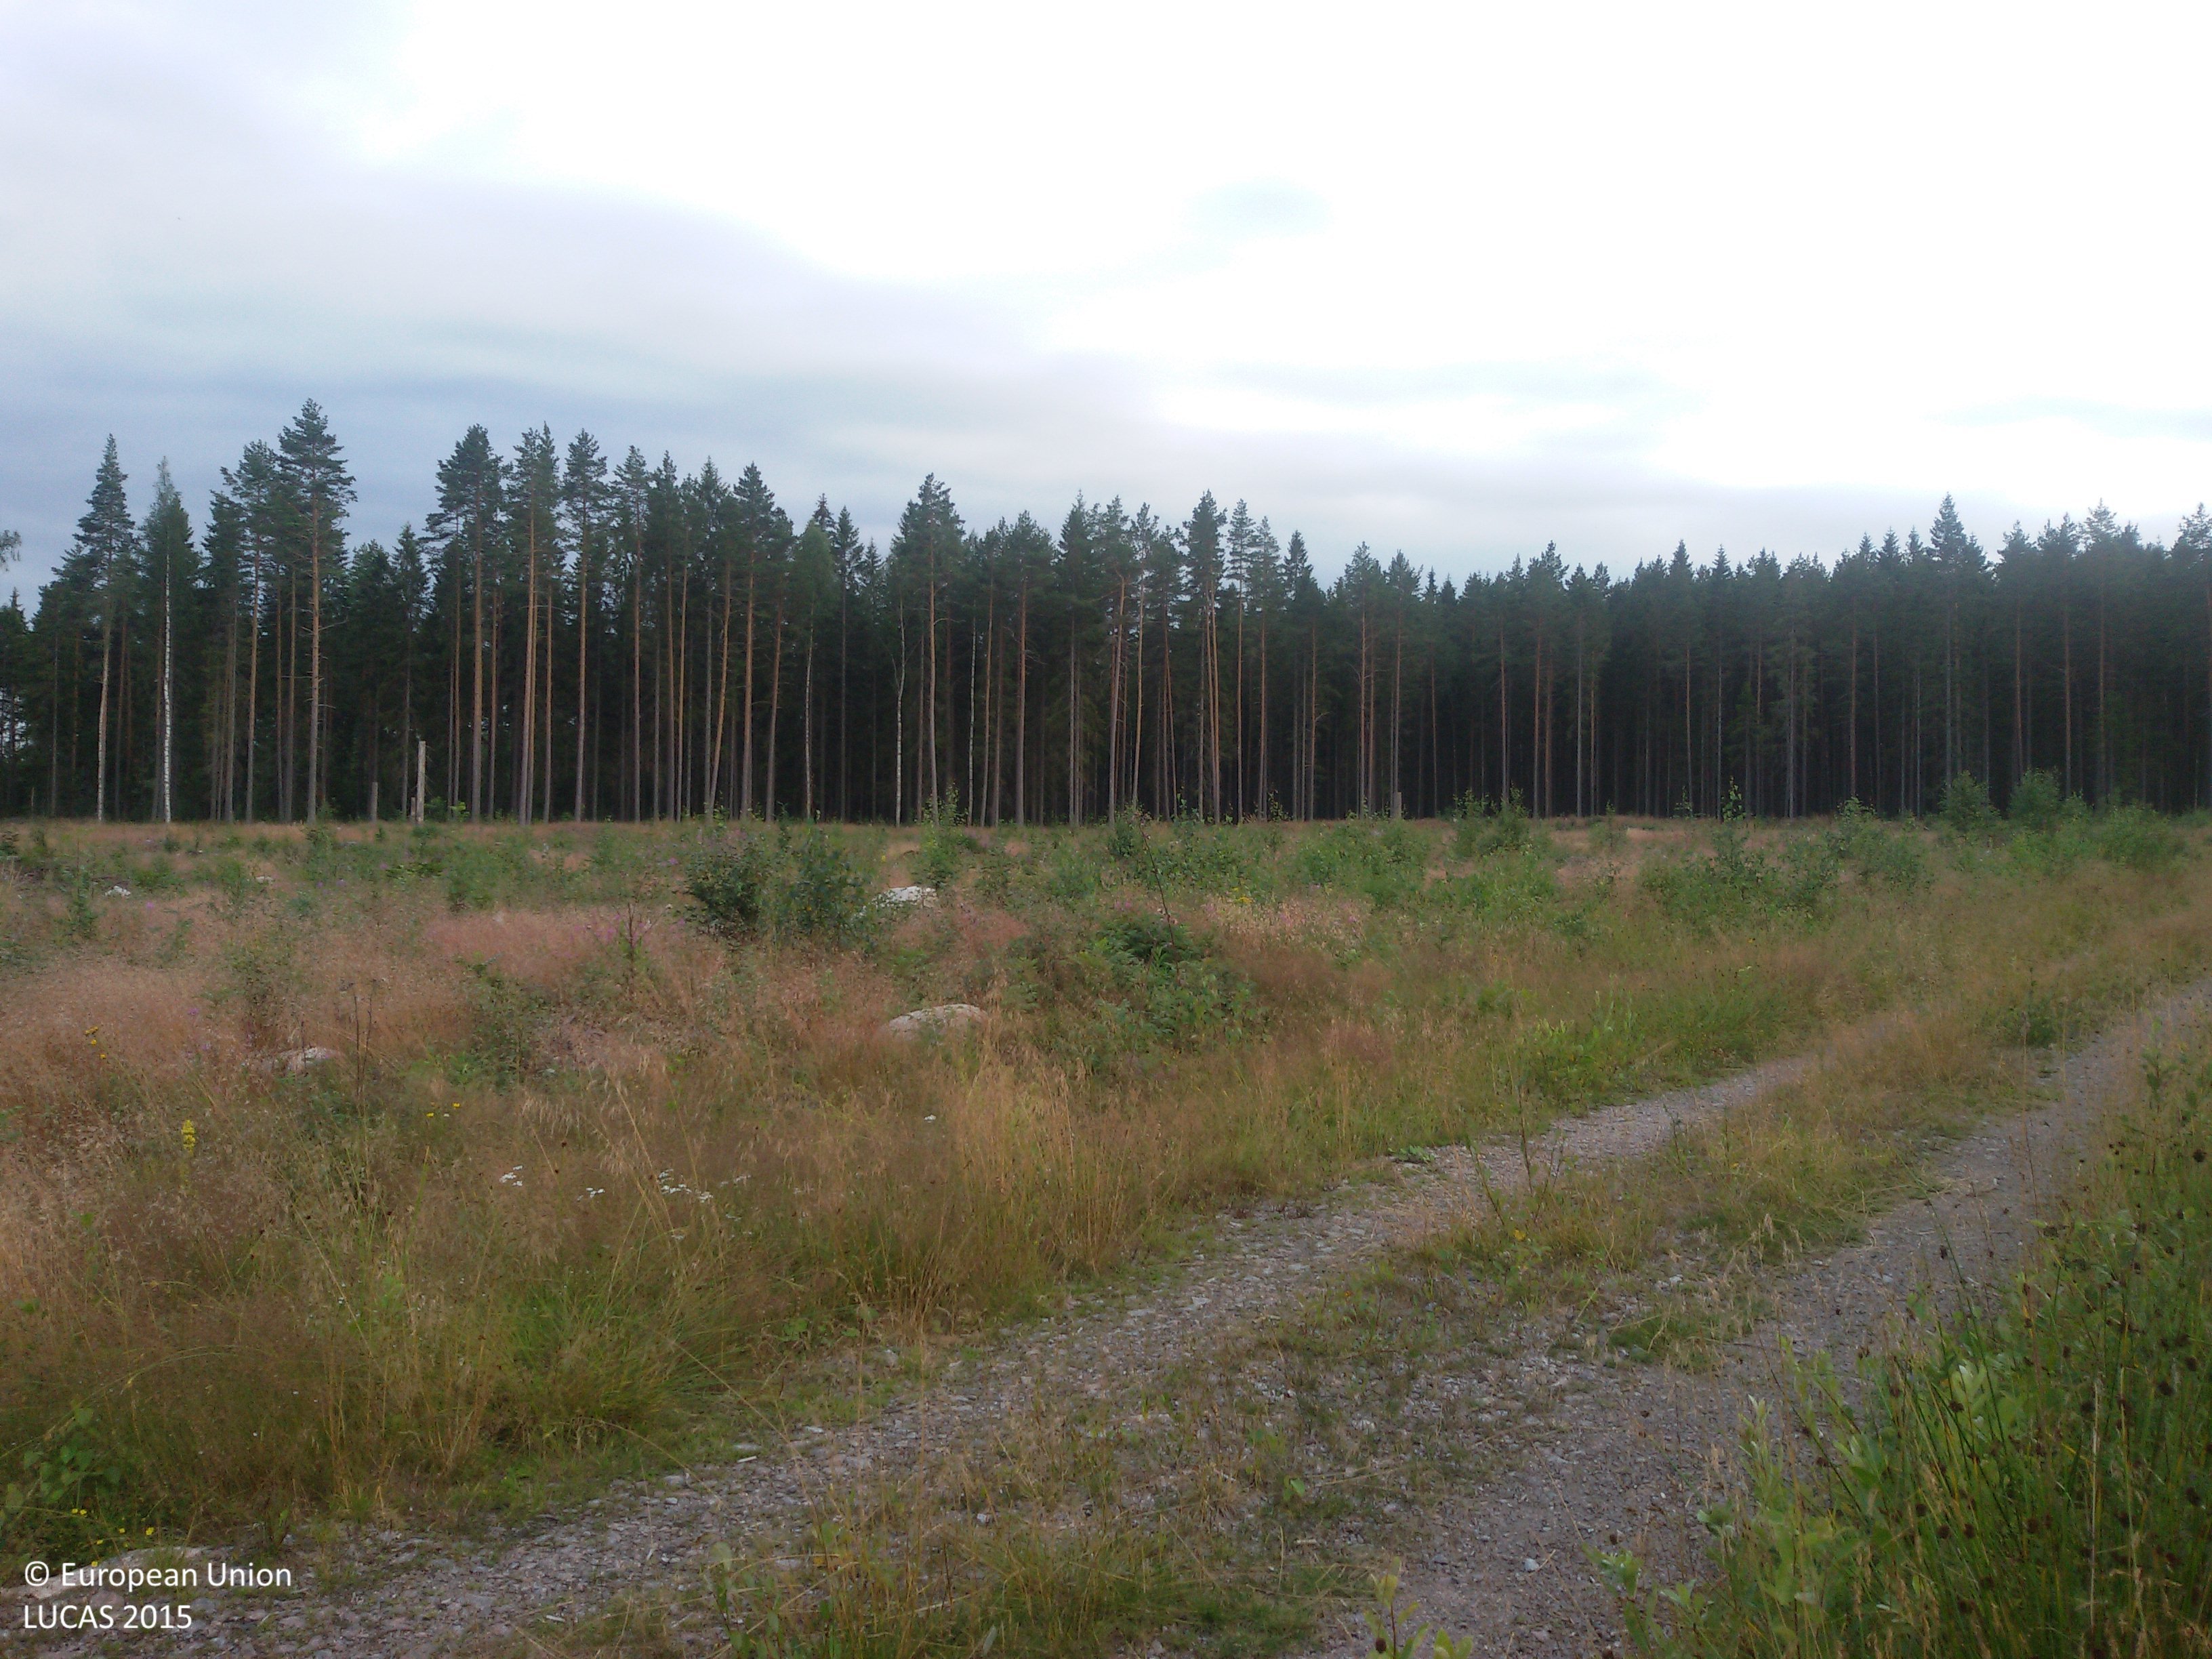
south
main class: Woodland
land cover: Broadleaved woodland
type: boreal forest
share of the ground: > 75 %
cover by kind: broadleaved forest trees 60 %, herbaceous plants 20 %, coniferous forest trees 15 %, shrubs 5 %
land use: Forestry
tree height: < 5 m
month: August
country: SE
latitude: 60.4996
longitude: 16.5243
